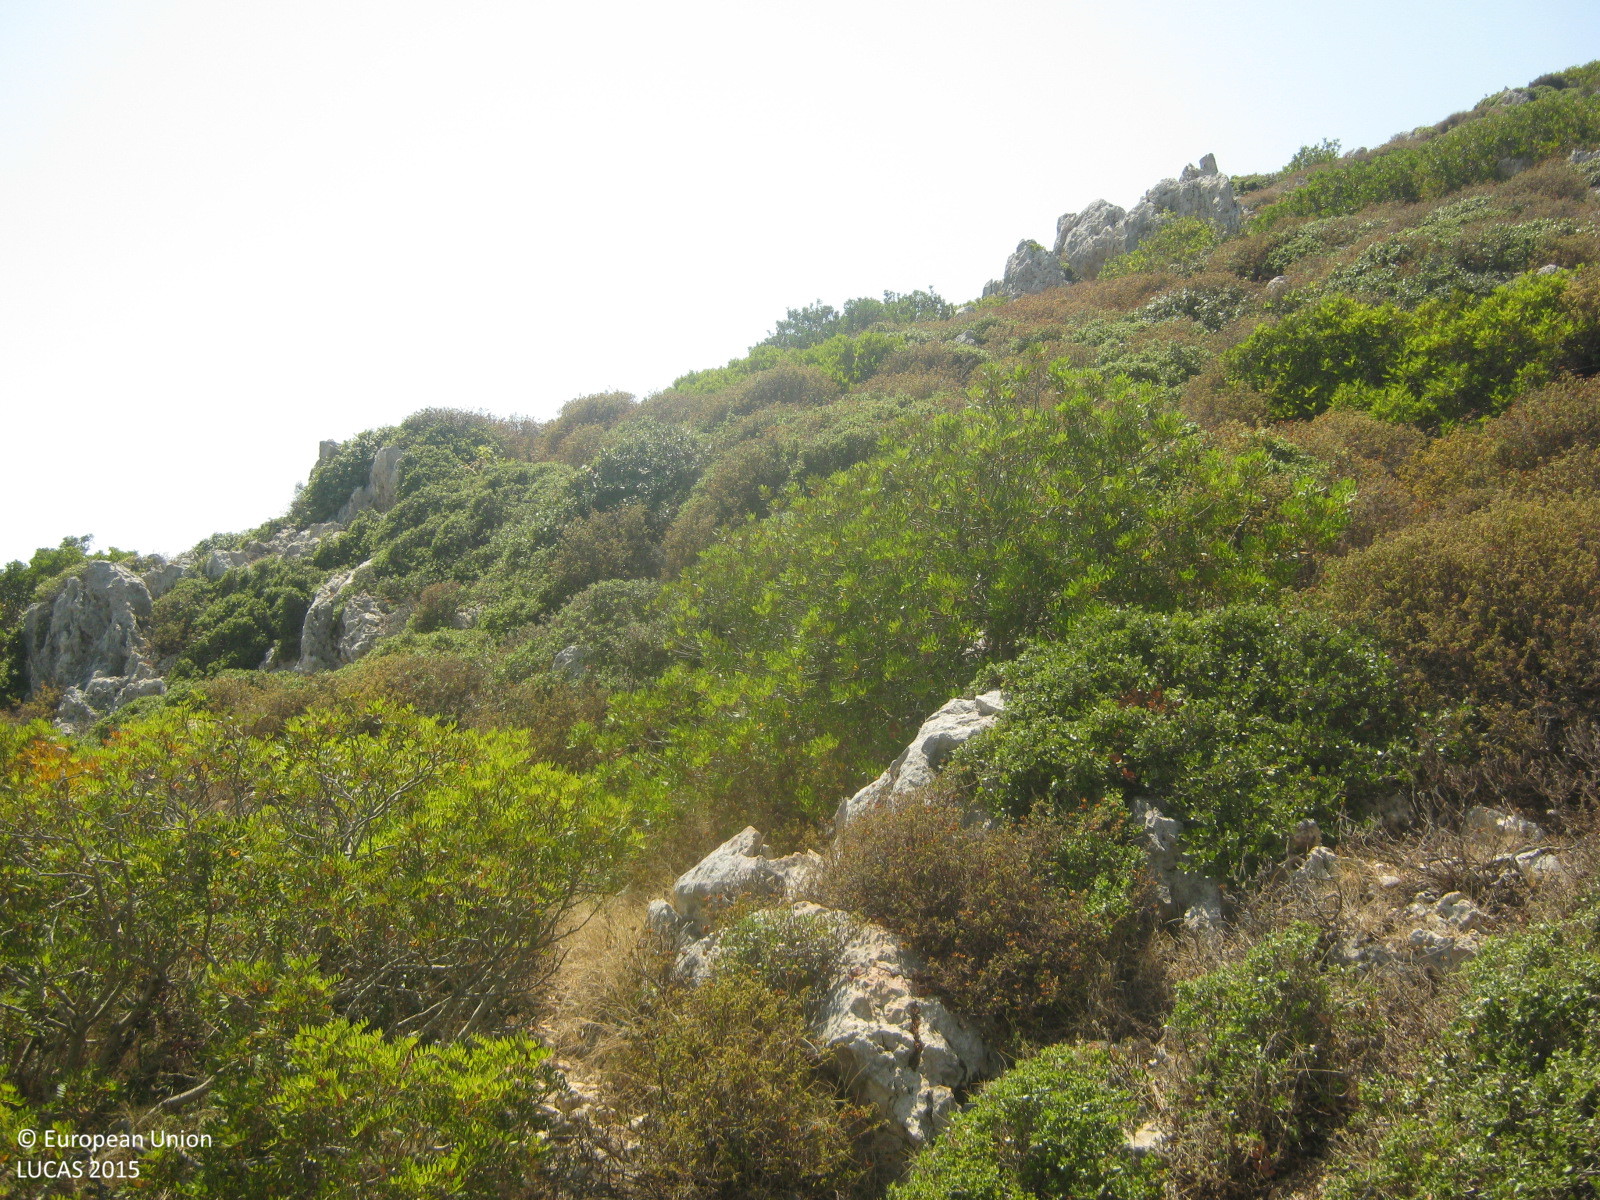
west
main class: Shrubland
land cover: Shrubland without tree cover
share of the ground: > 75 %
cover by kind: shrubs 90 %, consolidated bare surface 10 %
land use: Semi-natural and natural areas not in use
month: August
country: GR
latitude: 38.3055
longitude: 20.4255
